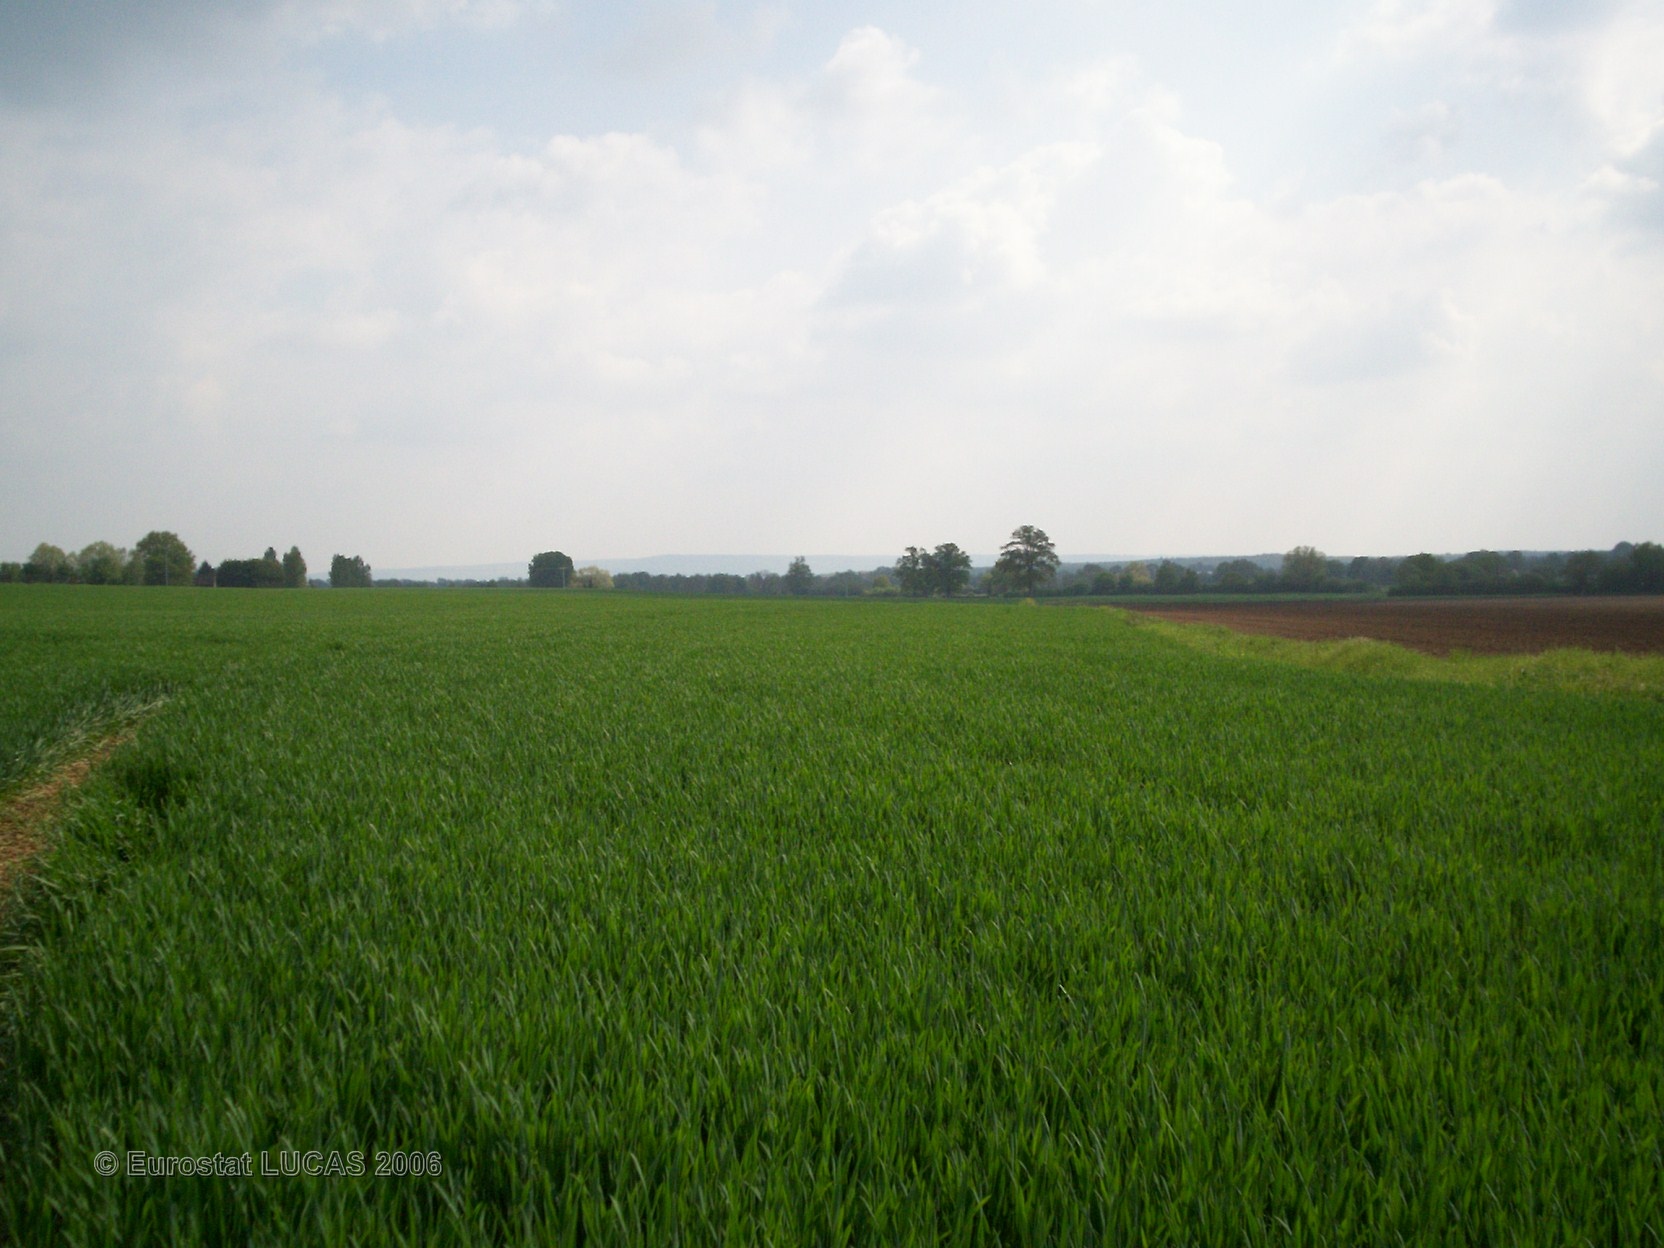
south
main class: Cropland
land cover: Common wheat
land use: Agriculture (excluding fallow land and kitchen gardens)
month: May
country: FR
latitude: 48.5191
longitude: 0.2930
